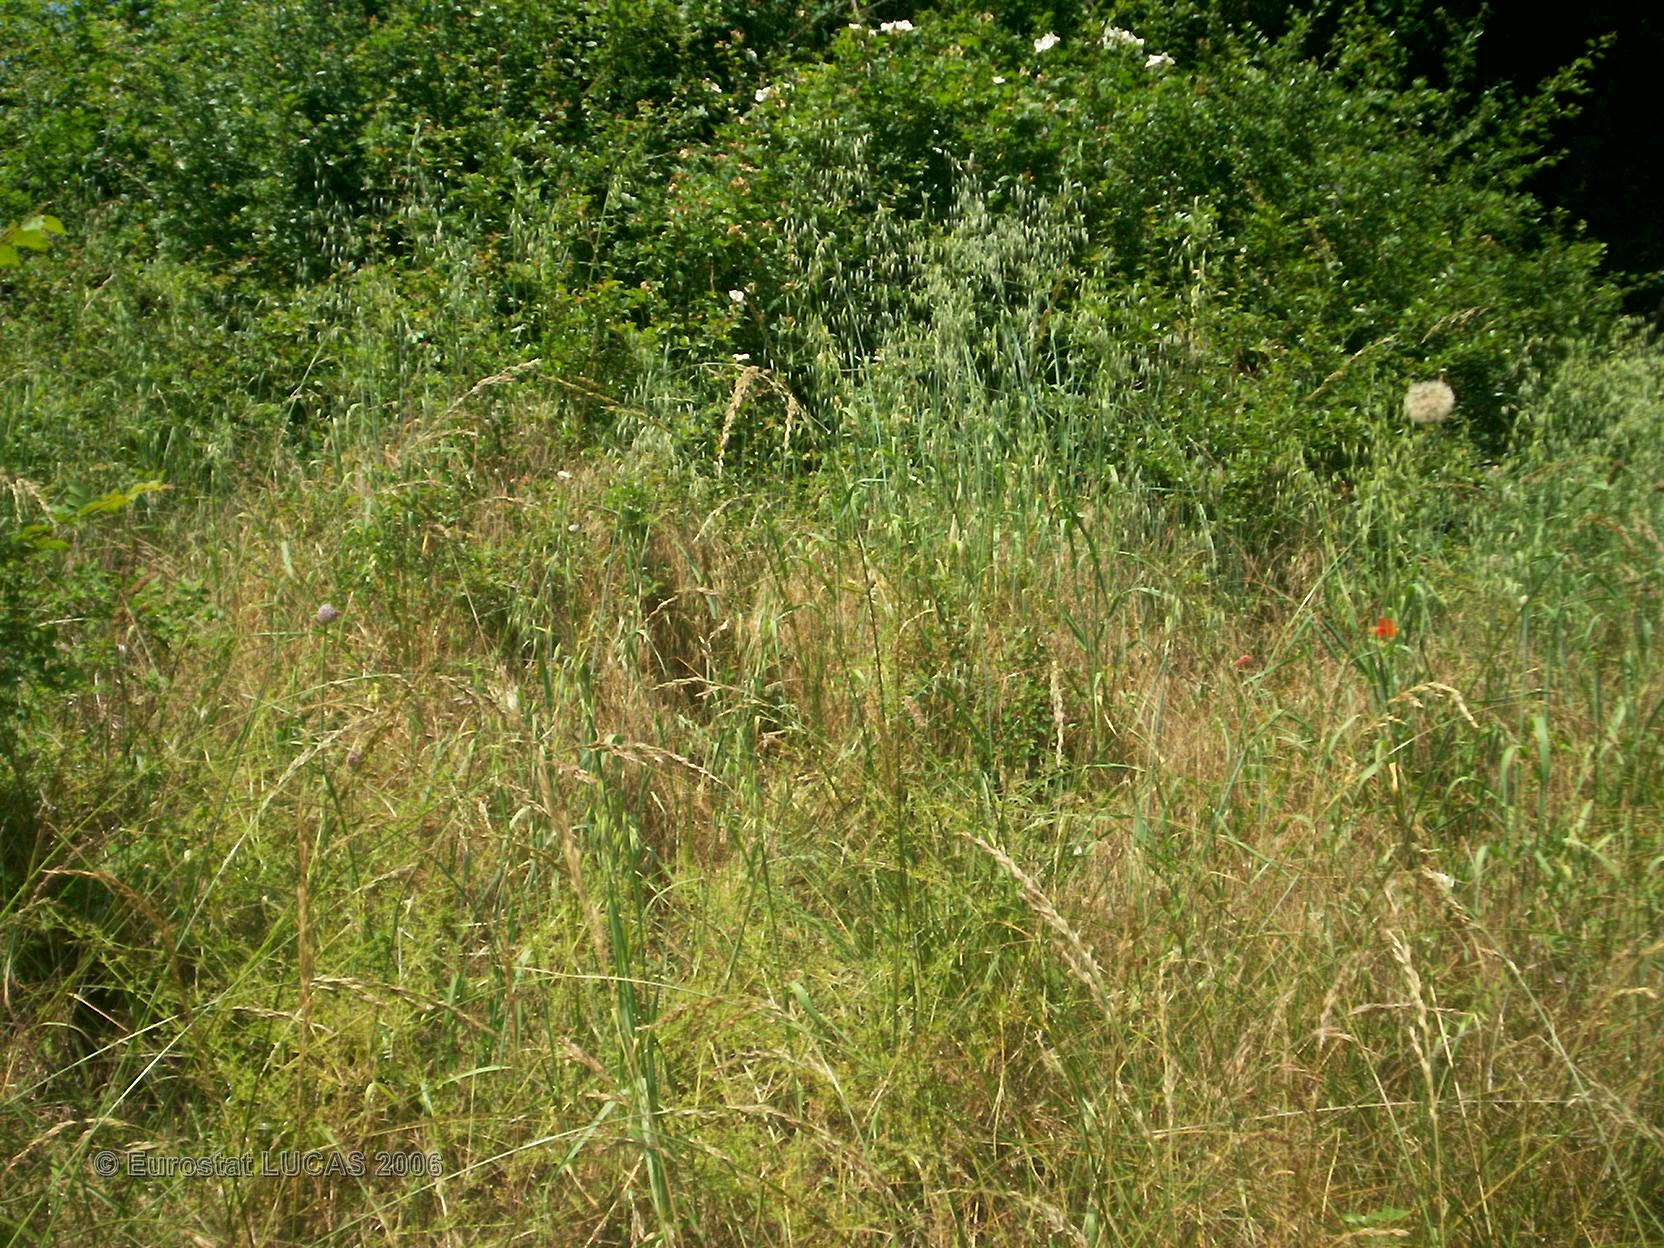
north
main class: Grassland
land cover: Grassland without tree/shrub cover
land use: Agriculture (excluding fallow land and kitchen gardens)
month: June
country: FR
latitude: 44.2082
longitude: 0.9485
